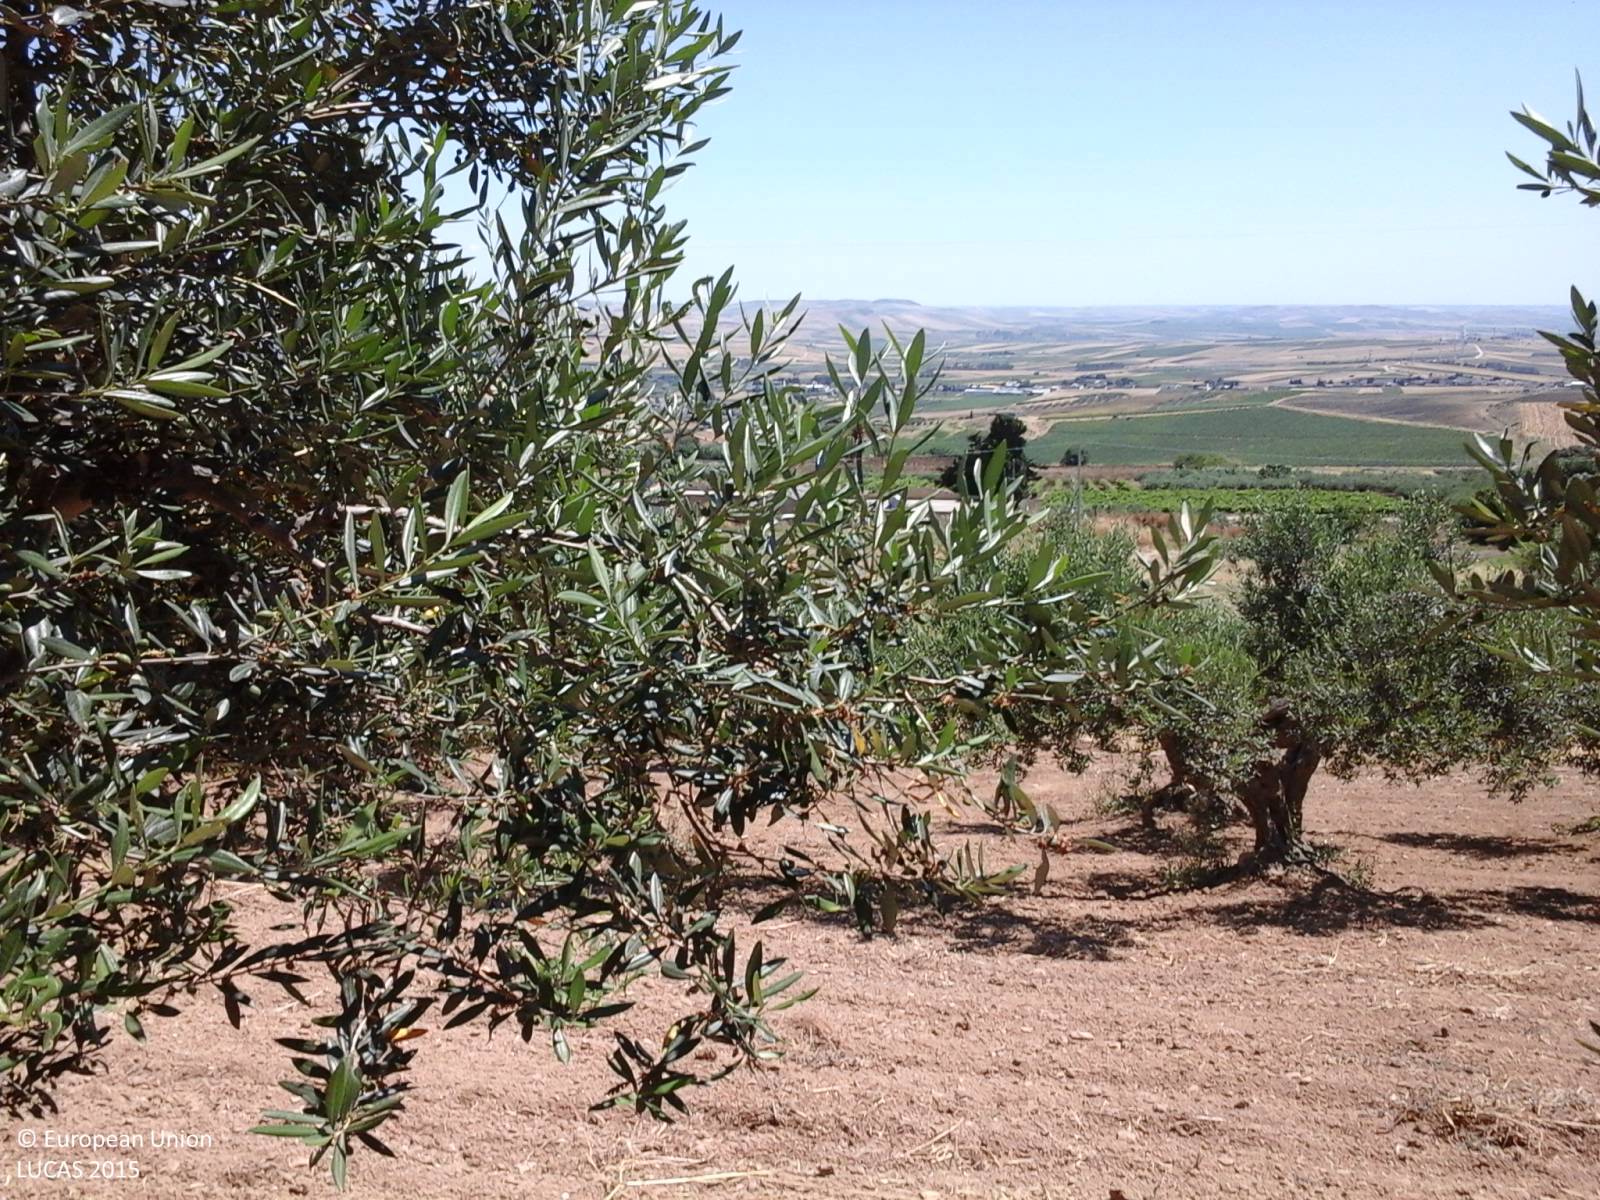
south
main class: Cropland
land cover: Olive groves
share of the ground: 50 - 75 %
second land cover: Other bare soil
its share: > 75 %
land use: Agriculture (excluding fallow land and kitchen gardens)
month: June
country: IT
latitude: 37.9822
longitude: 12.6789
